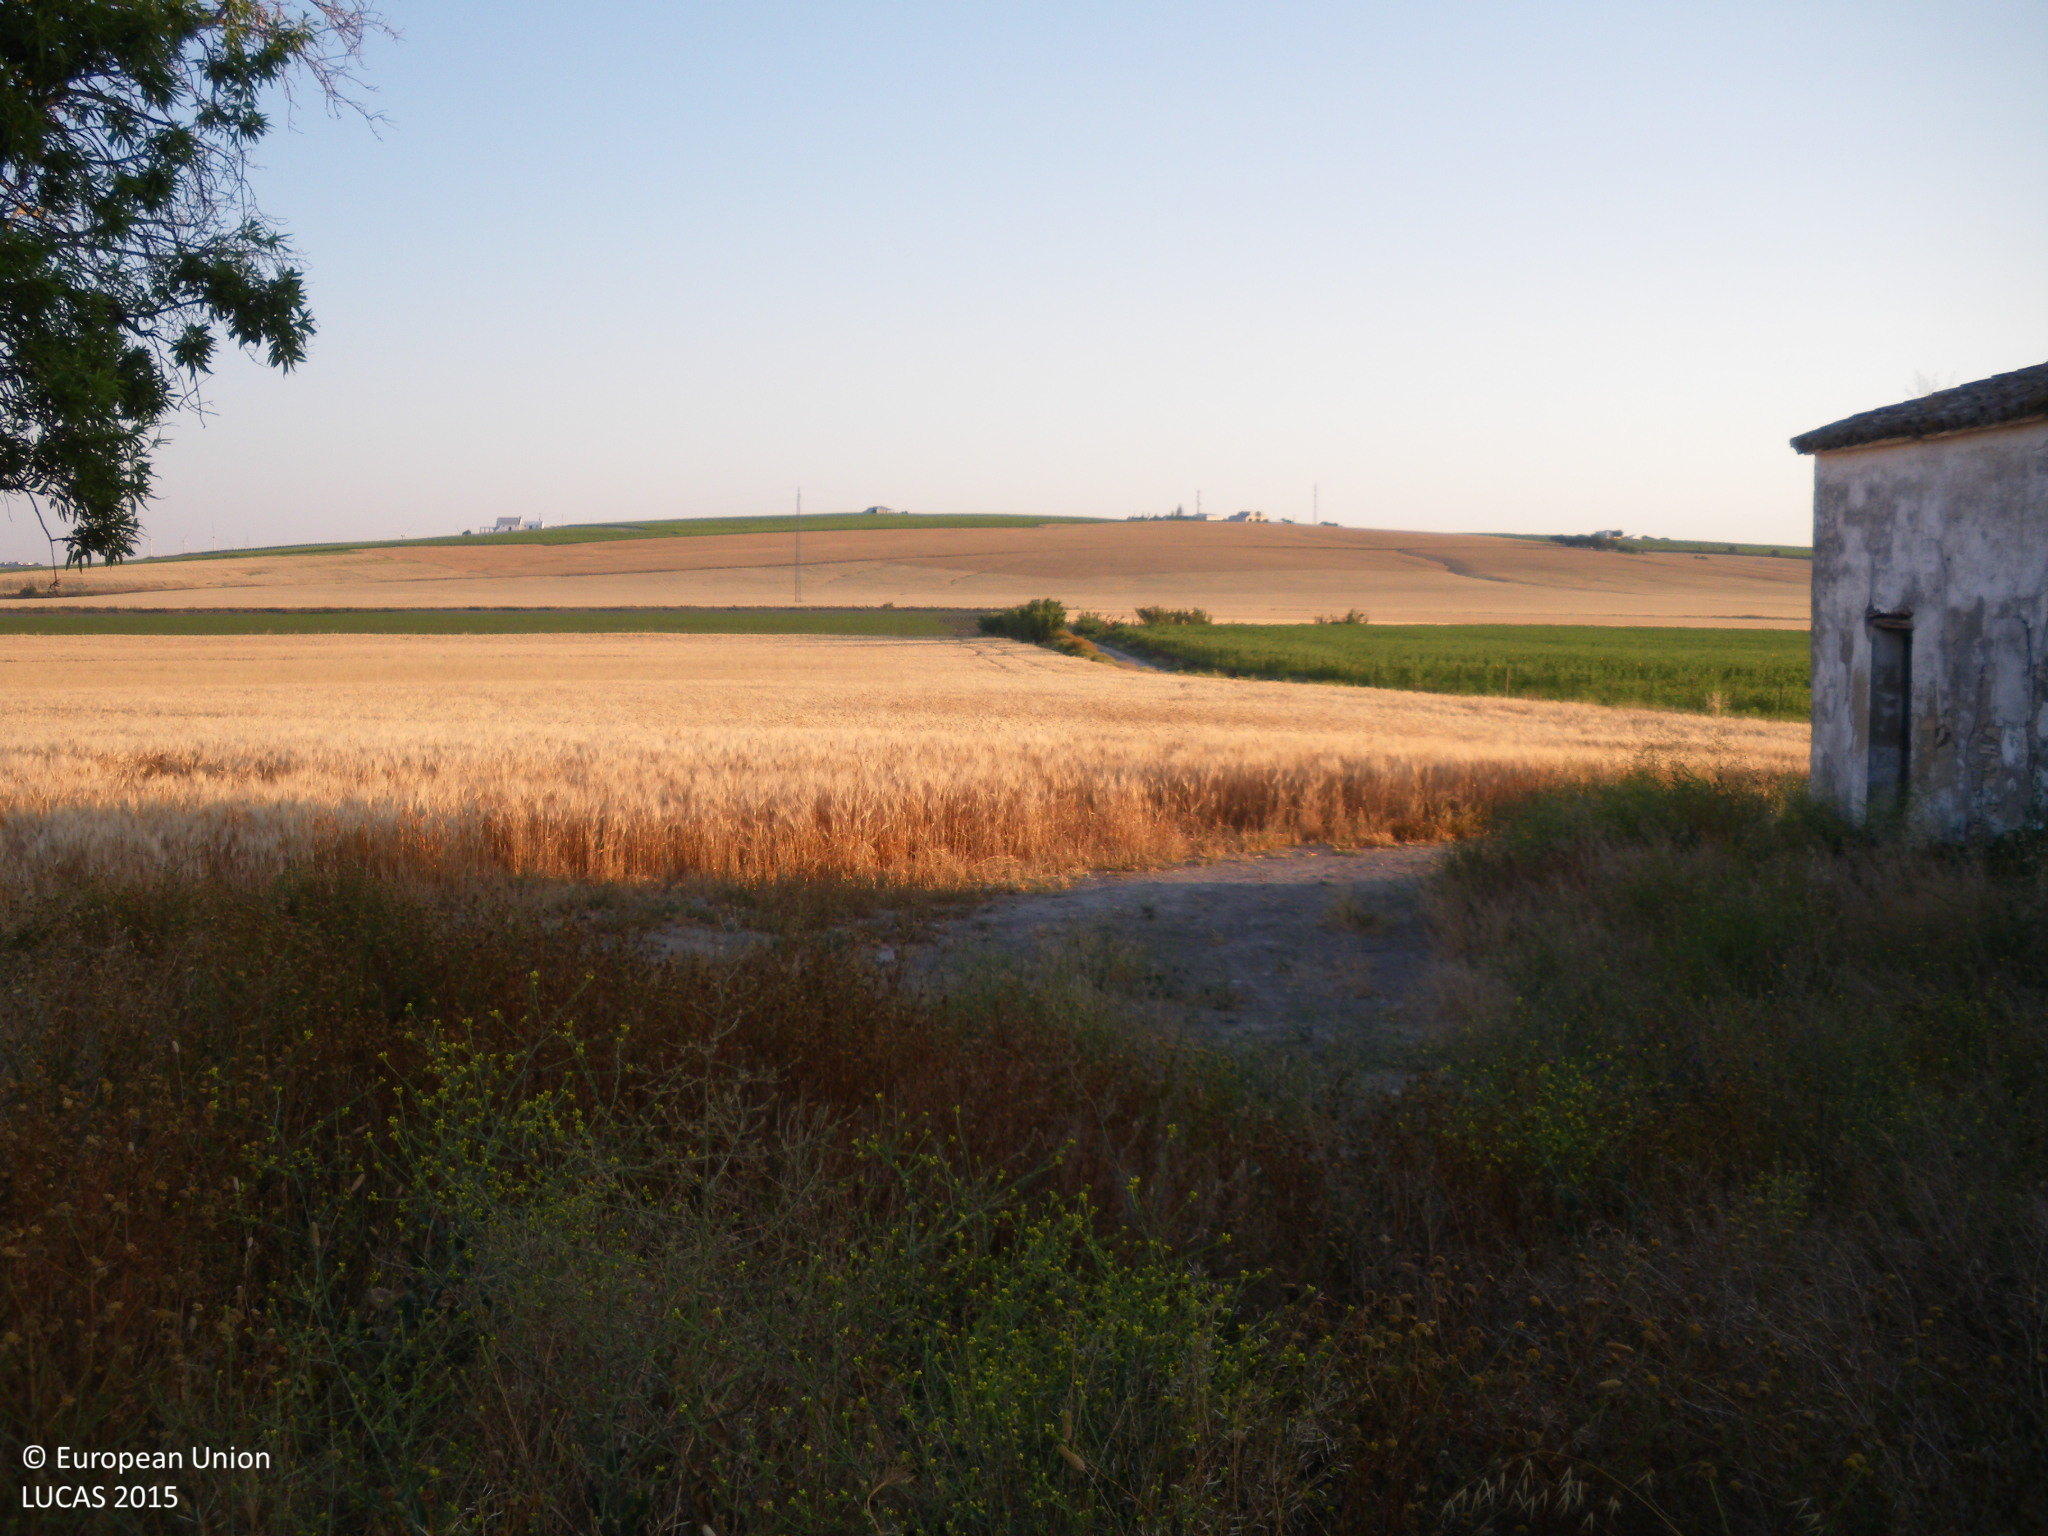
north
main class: Grassland
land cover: Grassland without tree/shrub cover
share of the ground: > 75 %
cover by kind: herbaceous plants 95 %, unconsolidated bare surface 5 %
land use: Semi-natural and natural areas not in use
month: May
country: ES
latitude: 36.6897
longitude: -6.2534
